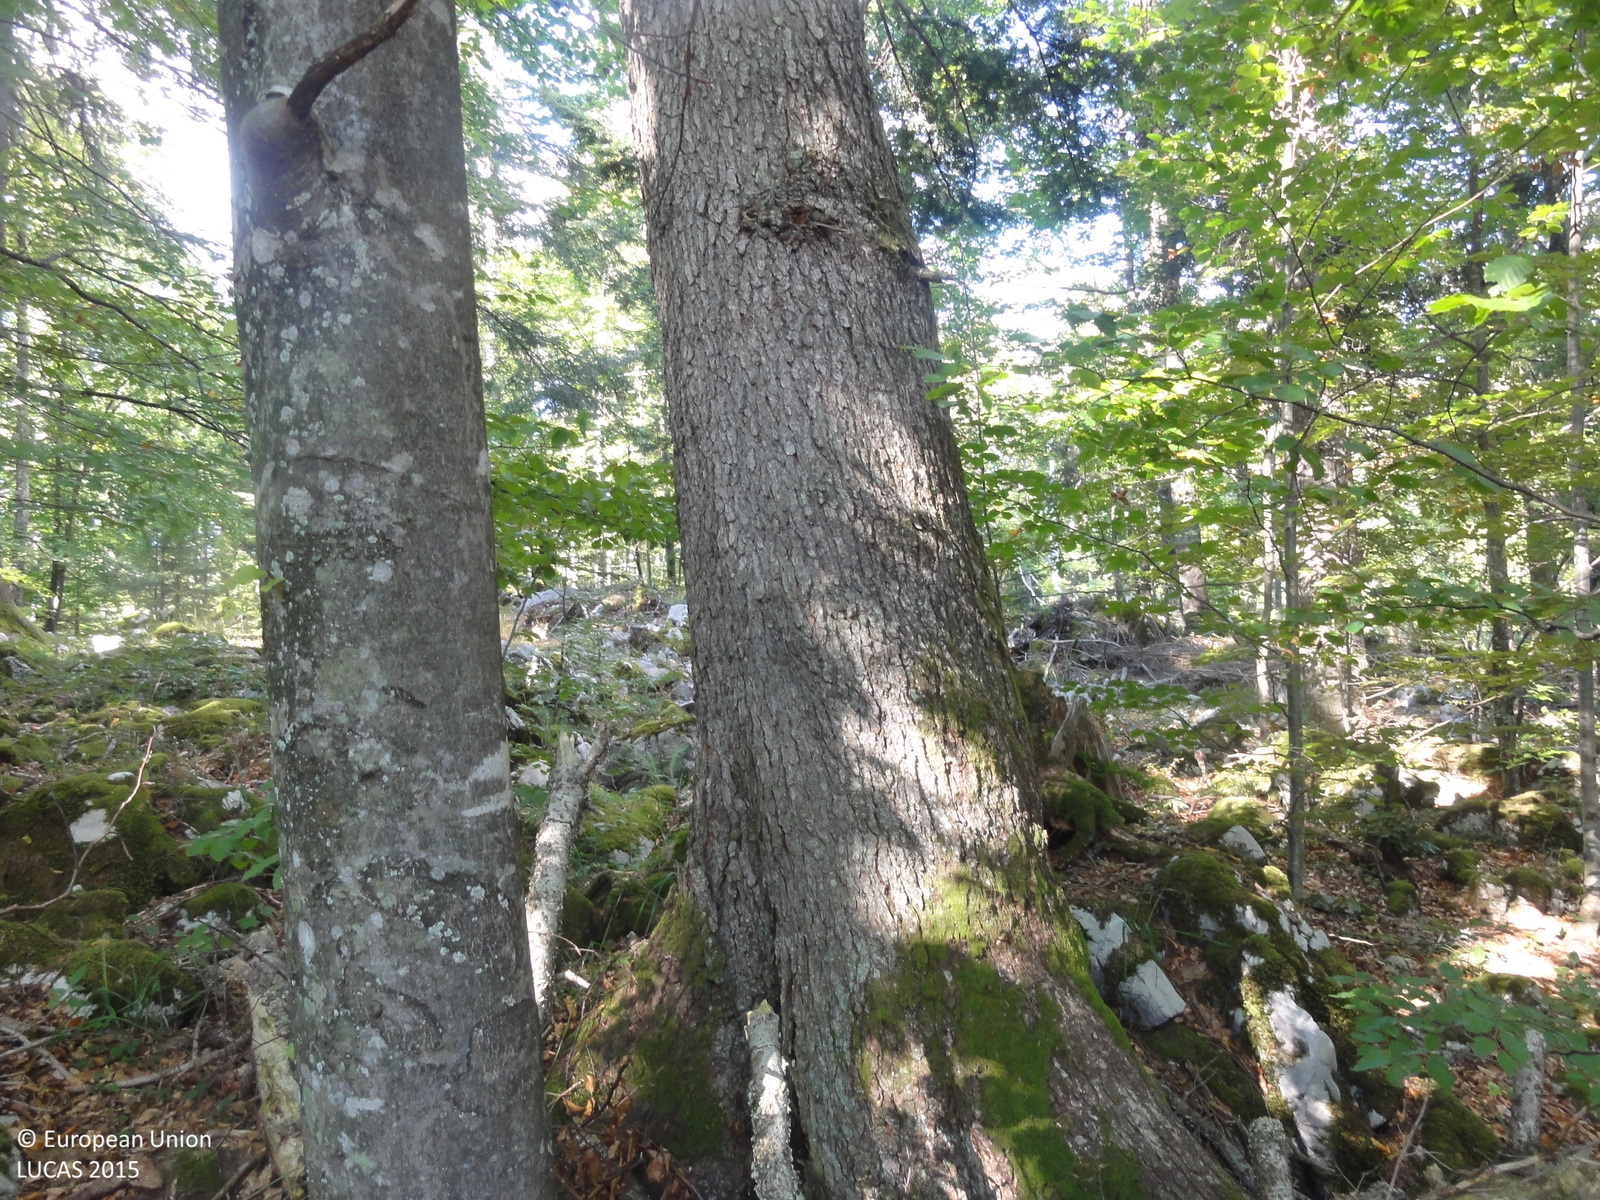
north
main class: Woodland
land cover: Spruce dominated mixed woodland
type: mountainous beech forest
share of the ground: > 75 %
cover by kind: broadleaved forest trees 60 %, coniferous forest trees 30 %, herbaceous plants 5 %, consolidated bare surface 5 %
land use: Forestry
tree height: > 5 m
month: September
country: SI
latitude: 45.6561
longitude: 15.0138
